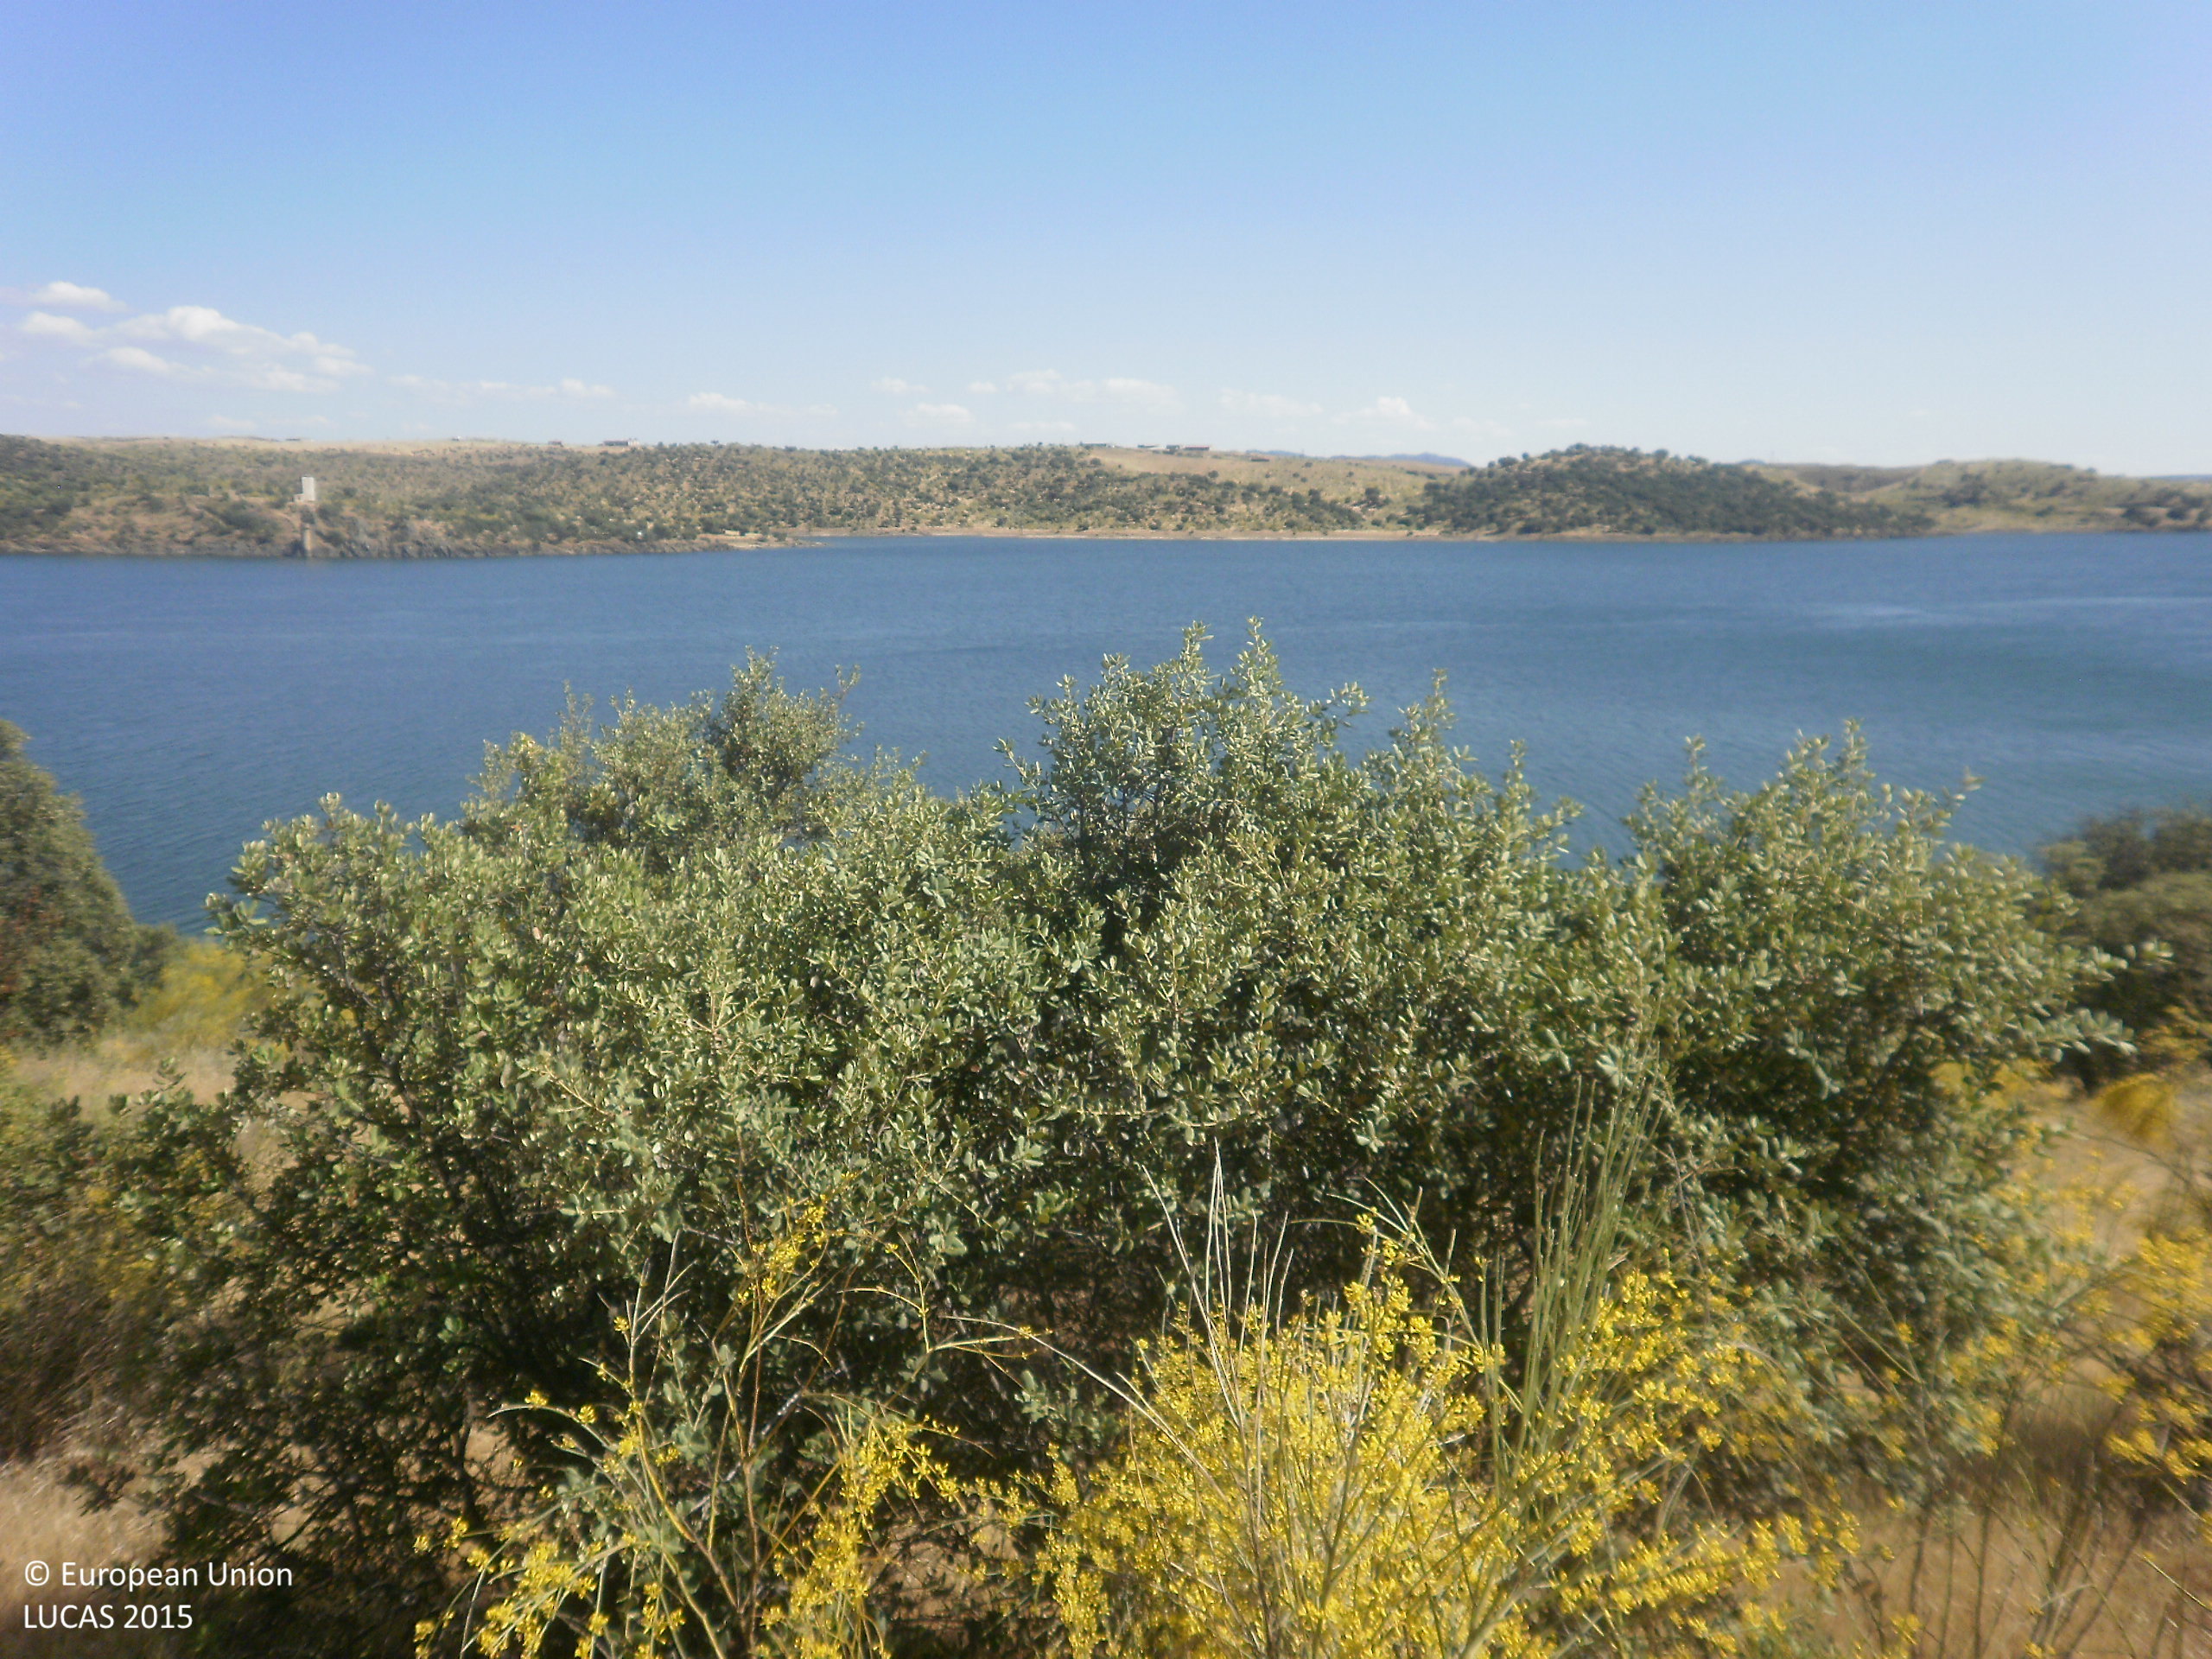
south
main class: Shrubland
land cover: Shrubland with sparse tree cover
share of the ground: 25 - 50 %
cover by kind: shrubs 90 %, broadleaved forest trees 5 %, herbaceous plants 5 %
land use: Agriculture (excluding fallow land and kitchen gardens)
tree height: < 5 m
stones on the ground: < 10 %
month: May
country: ES
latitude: 39.0972
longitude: -5.2929
